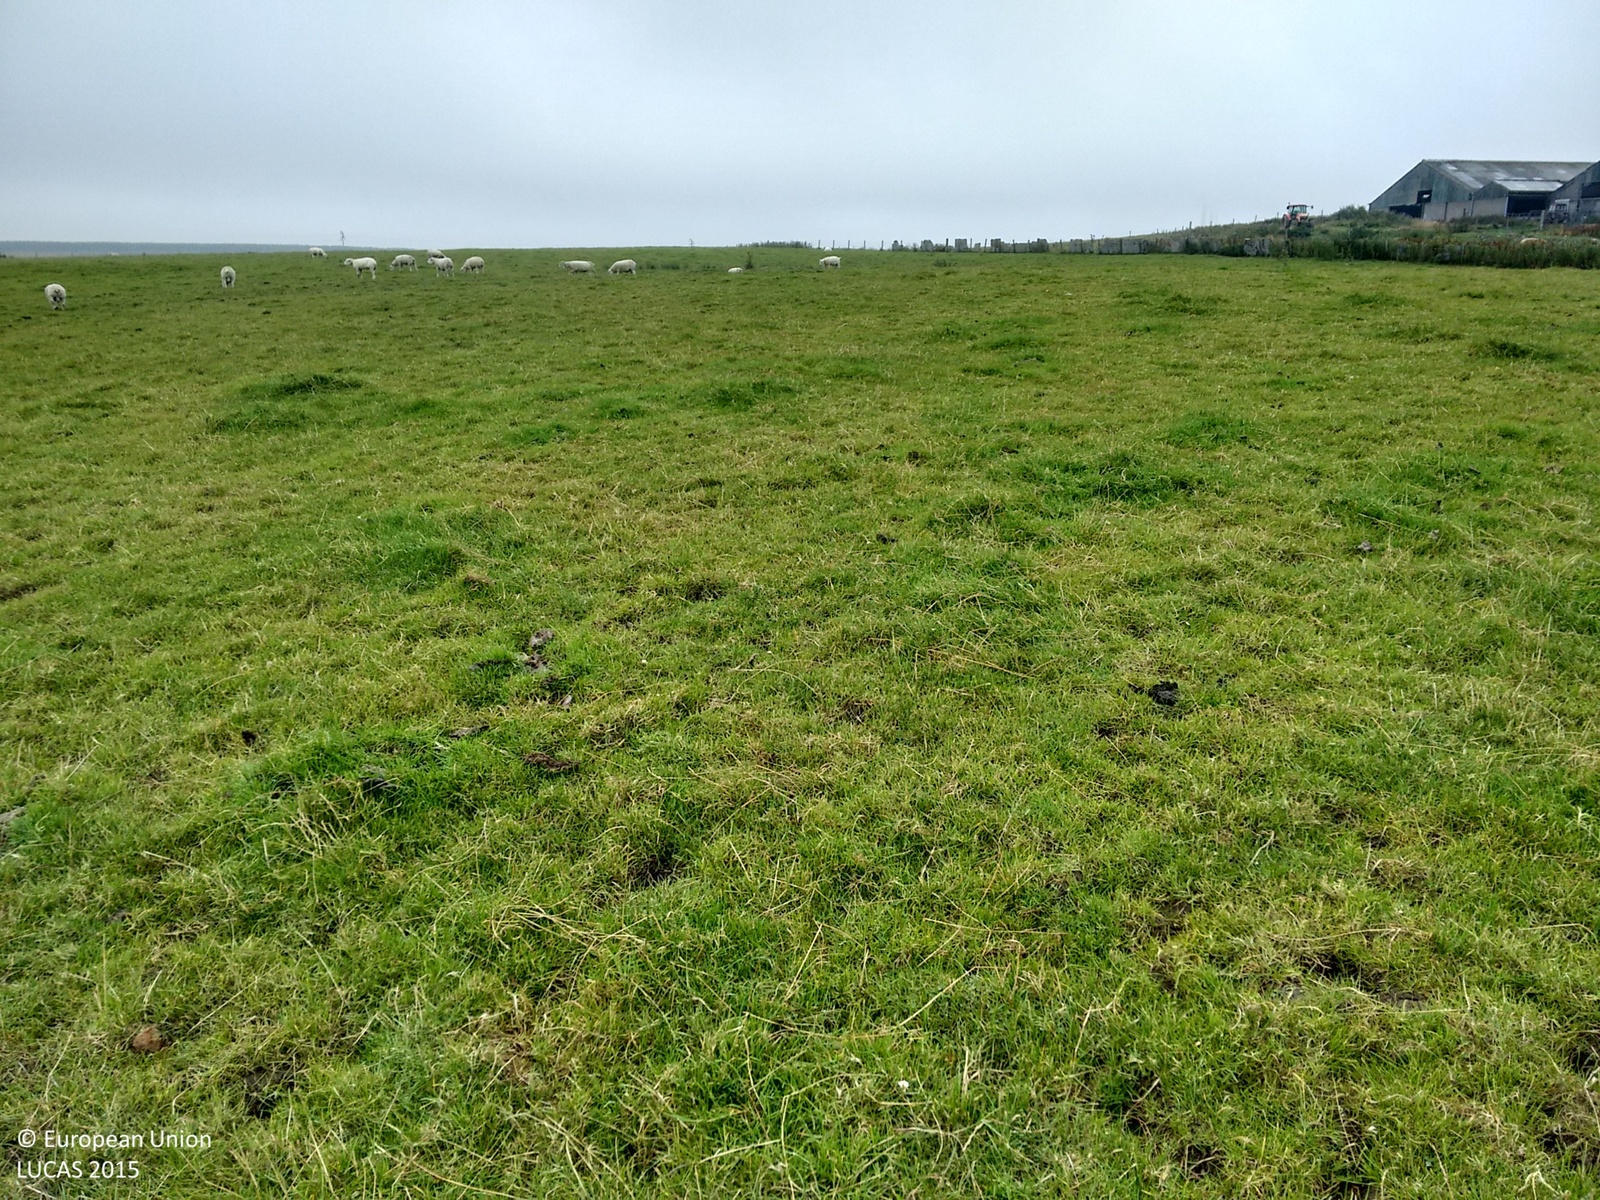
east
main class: Grassland
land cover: Grassland without tree/shrub cover
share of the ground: > 75 %
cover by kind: herbaceous plants 100 %
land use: Agriculture (excluding fallow land and kitchen gardens)
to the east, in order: Grassland without tree/shrub cover; Fences; Grassland without tree/shrub cover
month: August
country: GB
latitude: 58.4526
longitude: -3.2727
